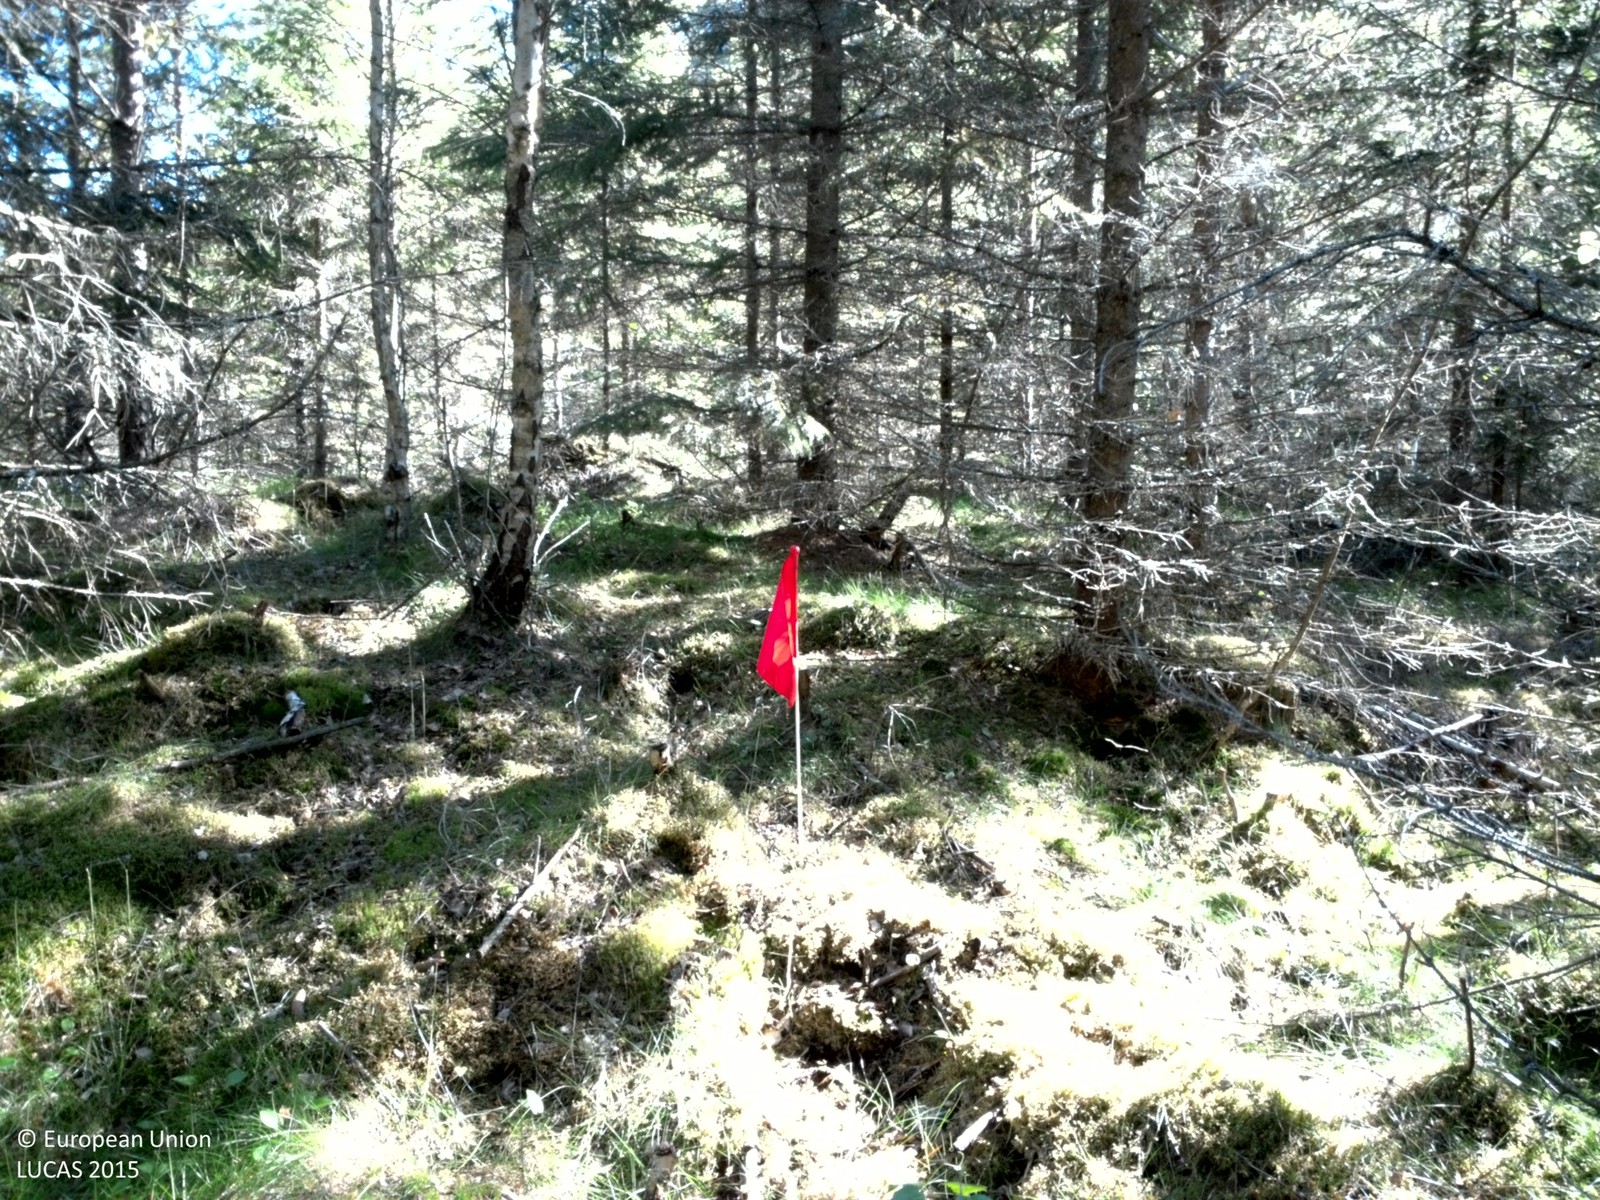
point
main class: Woodland
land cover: Spruce dominated mixed woodland
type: boreal forest
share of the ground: > 75 %
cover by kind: coniferous forest trees 70 %, broadleaved forest trees 25 %, lichens and mosses 5 %
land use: Forestry
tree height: > 5 m
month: June
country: SE
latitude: 58.7018
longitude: 14.5320
